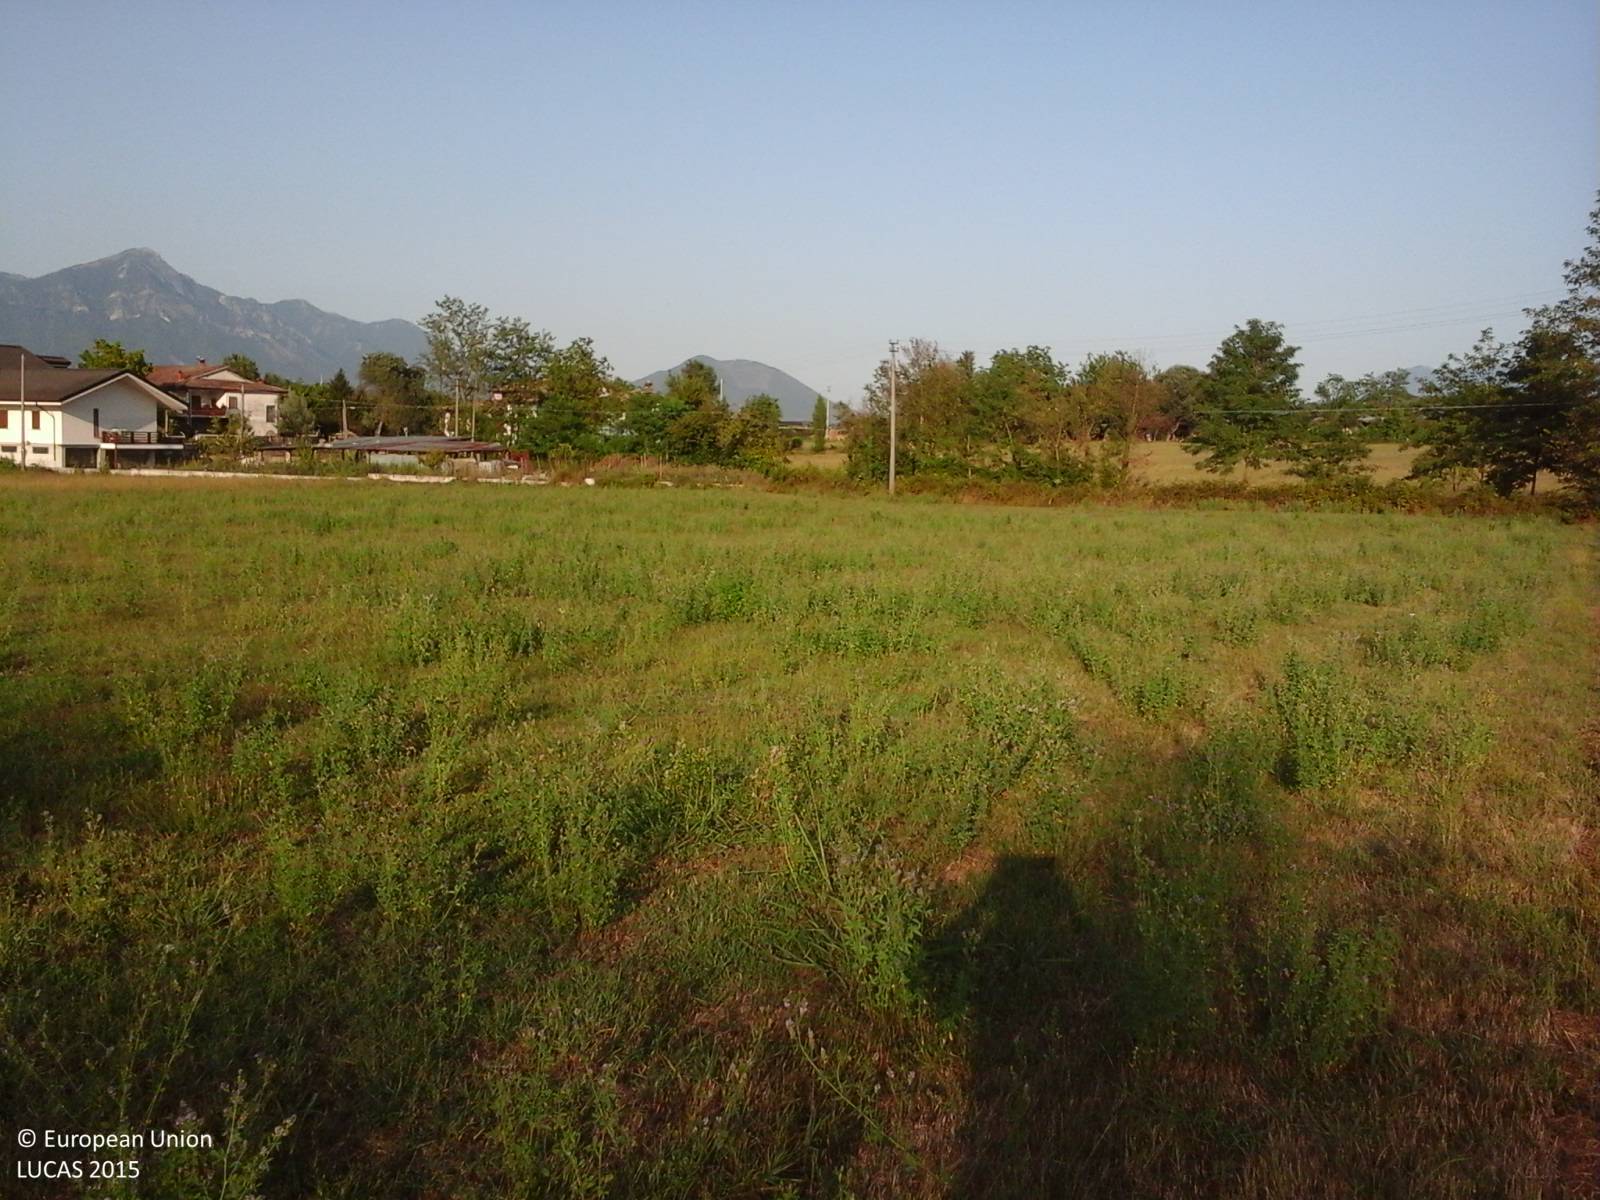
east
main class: Cropland
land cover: Lucerne
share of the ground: > 75 %
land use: Agriculture (excluding fallow land and kitchen gardens)
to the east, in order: Other fruit trees and berries; Lucerne; Electric lines; Ditches and canals; Grass margins; Paved roads, cycling and walking lanes; Grass margins; Electric lines; Abandoned hedges; Temporary grasslands; Lines of trees; Tracks; Electric lines; Spontaneously vegetated surfaces; Temporary grasslands; Electric lines; Temporary grasslands
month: July
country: IT
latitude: 41.2582
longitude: 14.3398
